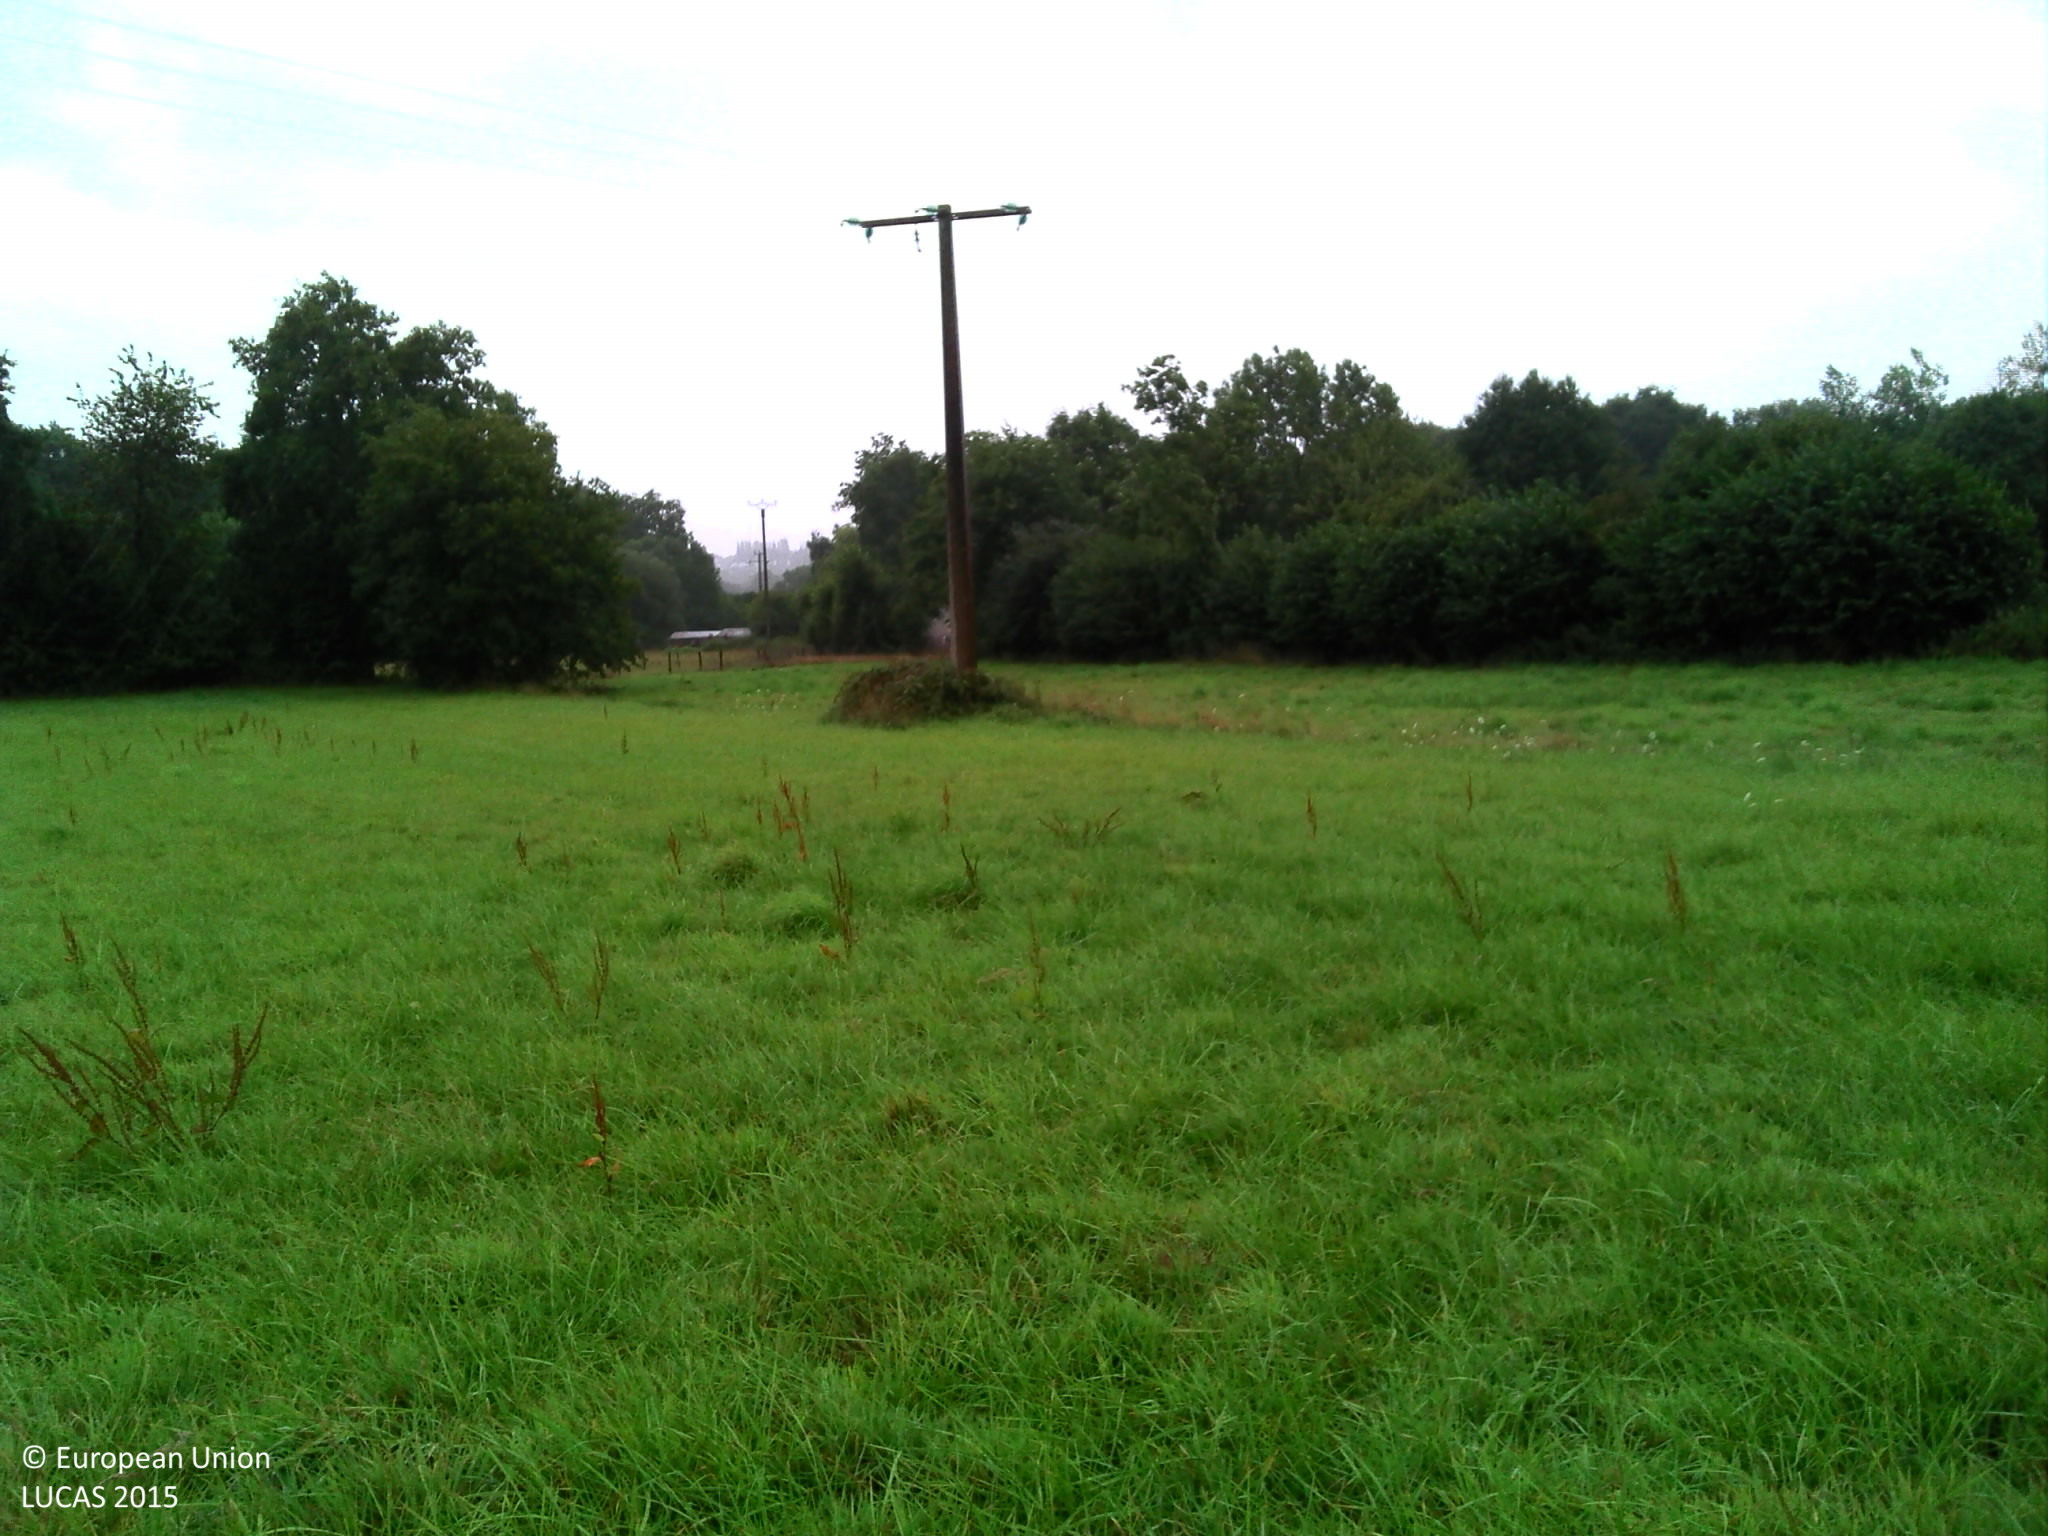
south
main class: Grassland
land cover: Grassland without tree/shrub cover
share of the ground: > 75 %
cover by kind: herbaceous plants 90 %, unconsolidated bare surface 10 %
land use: Agriculture (excluding fallow land and kitchen gardens)
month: July
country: FR
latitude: 48.5104
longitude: -2.0069
